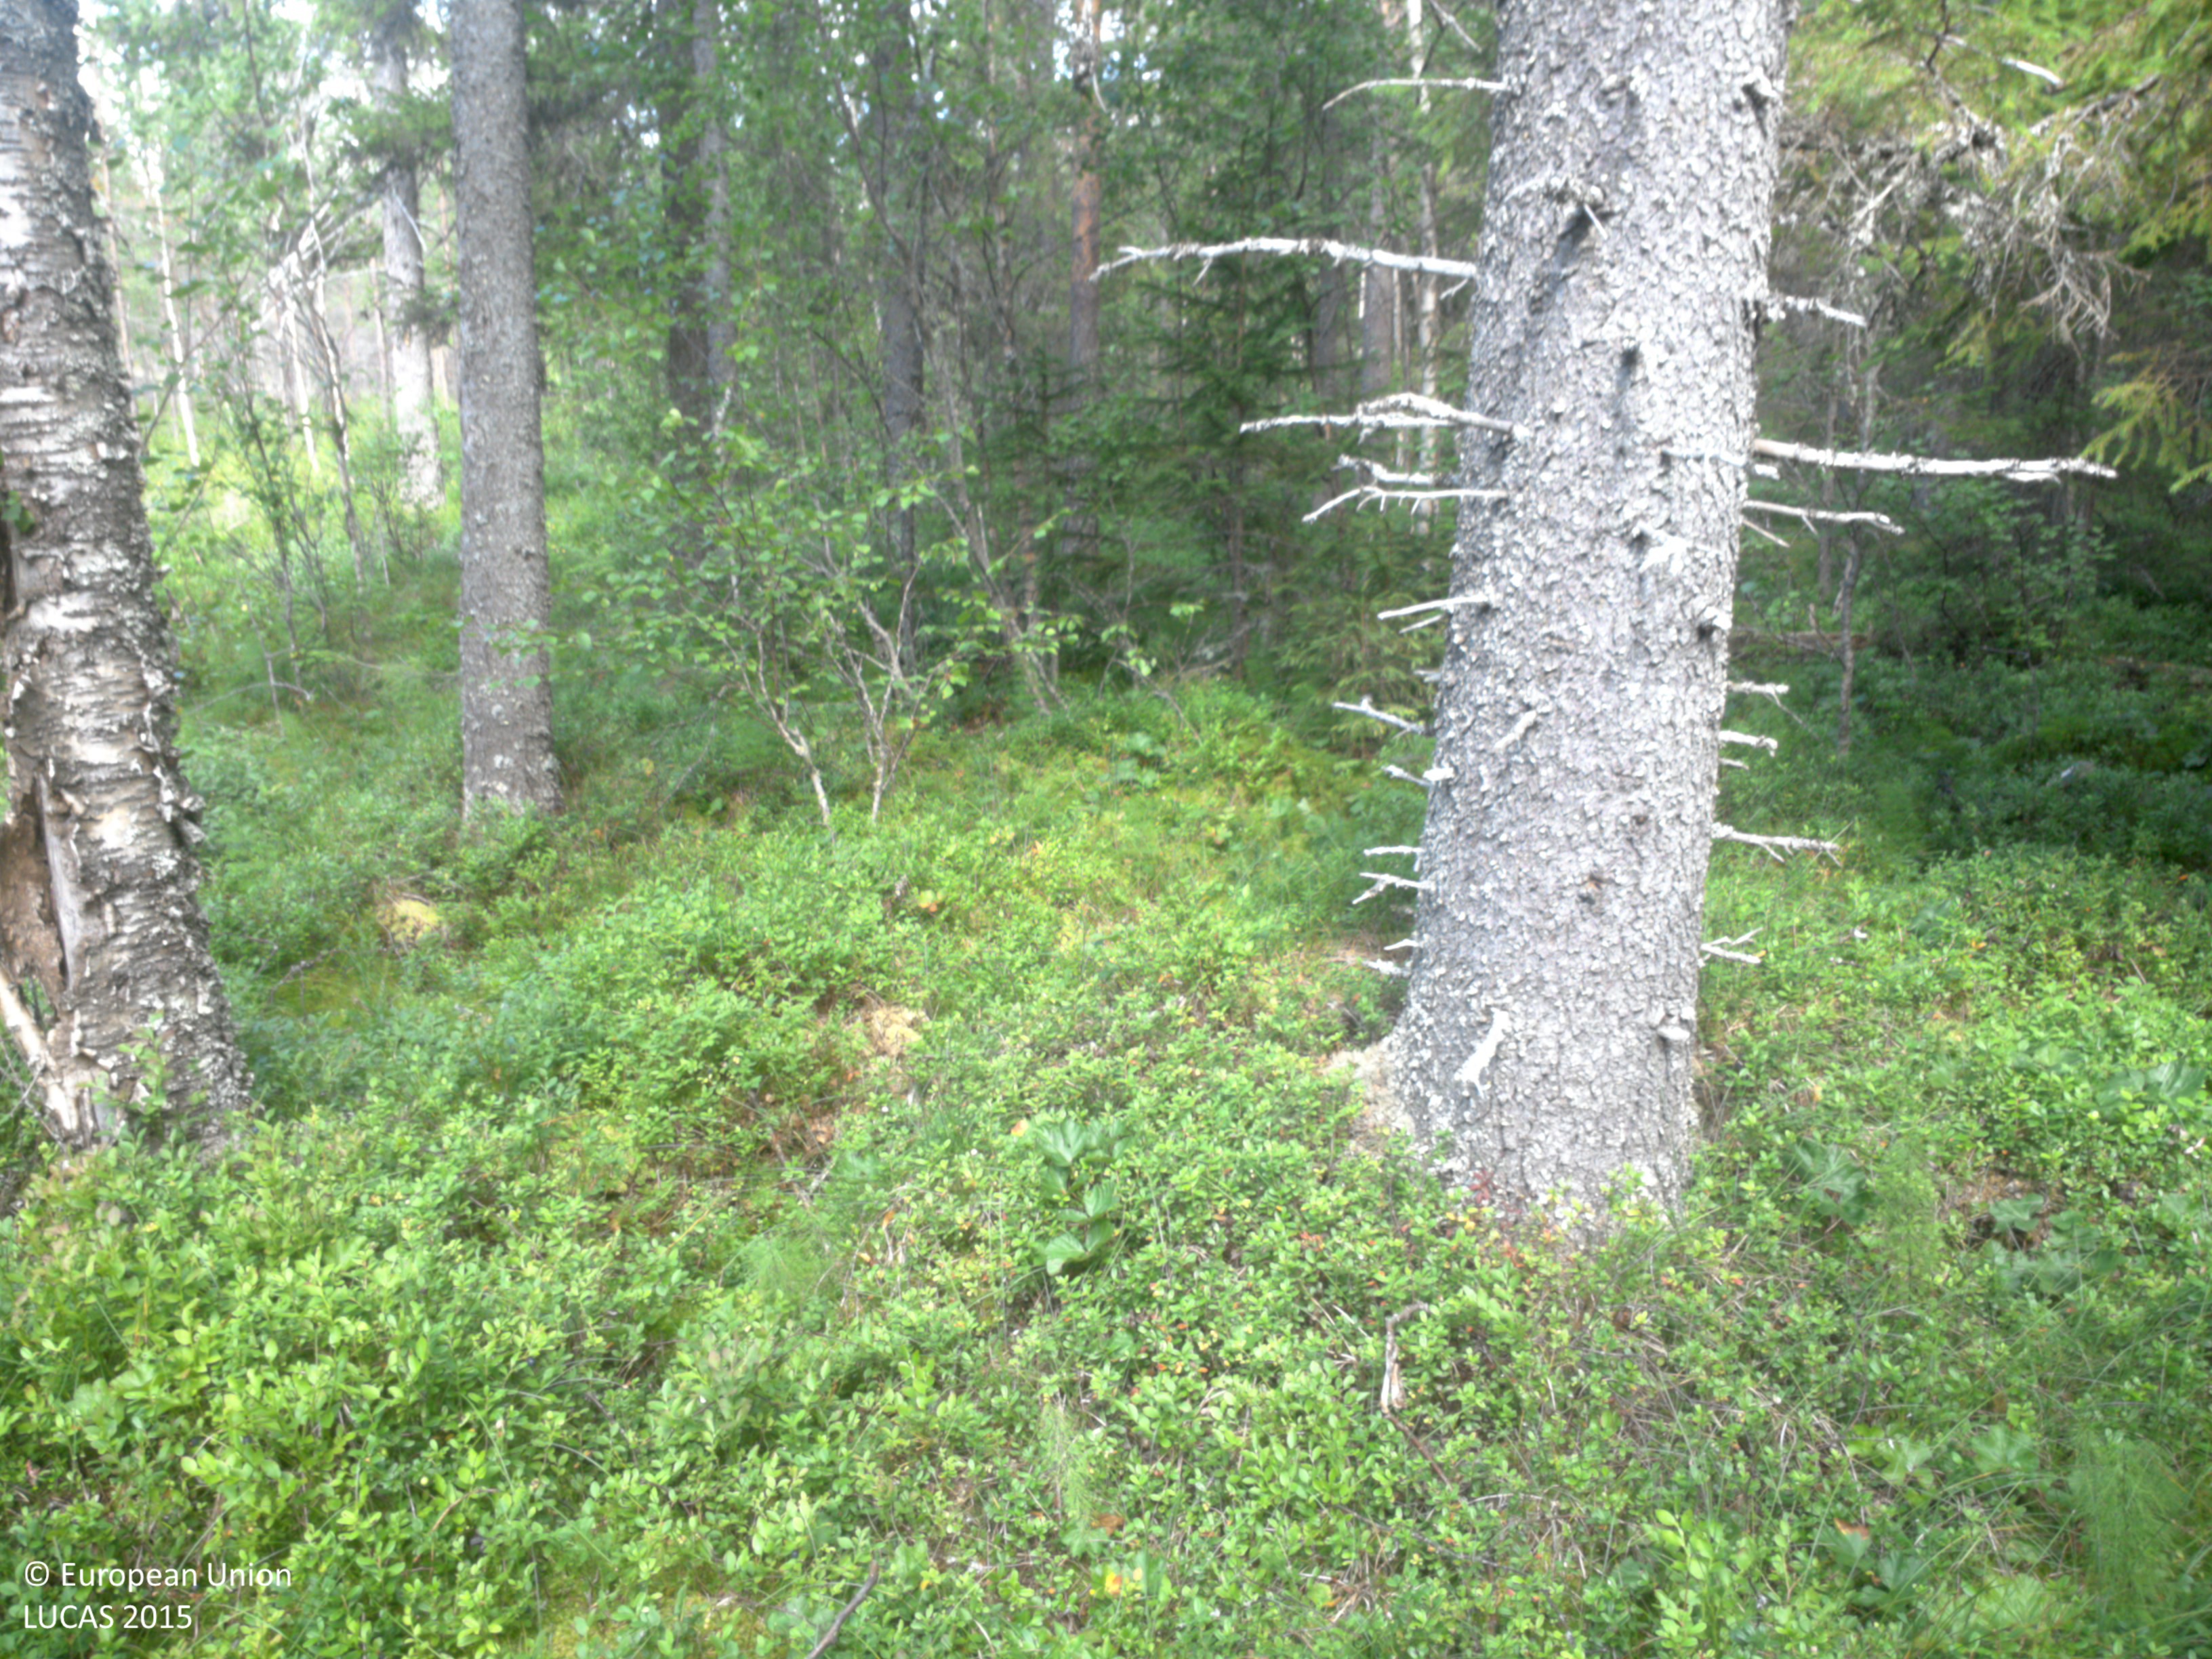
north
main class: Woodland
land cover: Other mixed woodland
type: boreal forest
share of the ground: 50 - 75 %
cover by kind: coniferous forest trees 40 %, shrubs 35 %, broadleaved forest trees 25 %
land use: Forestry
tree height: > 5 m
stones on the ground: < 10 %
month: August
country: SE
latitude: 63.5844
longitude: 19.5091
